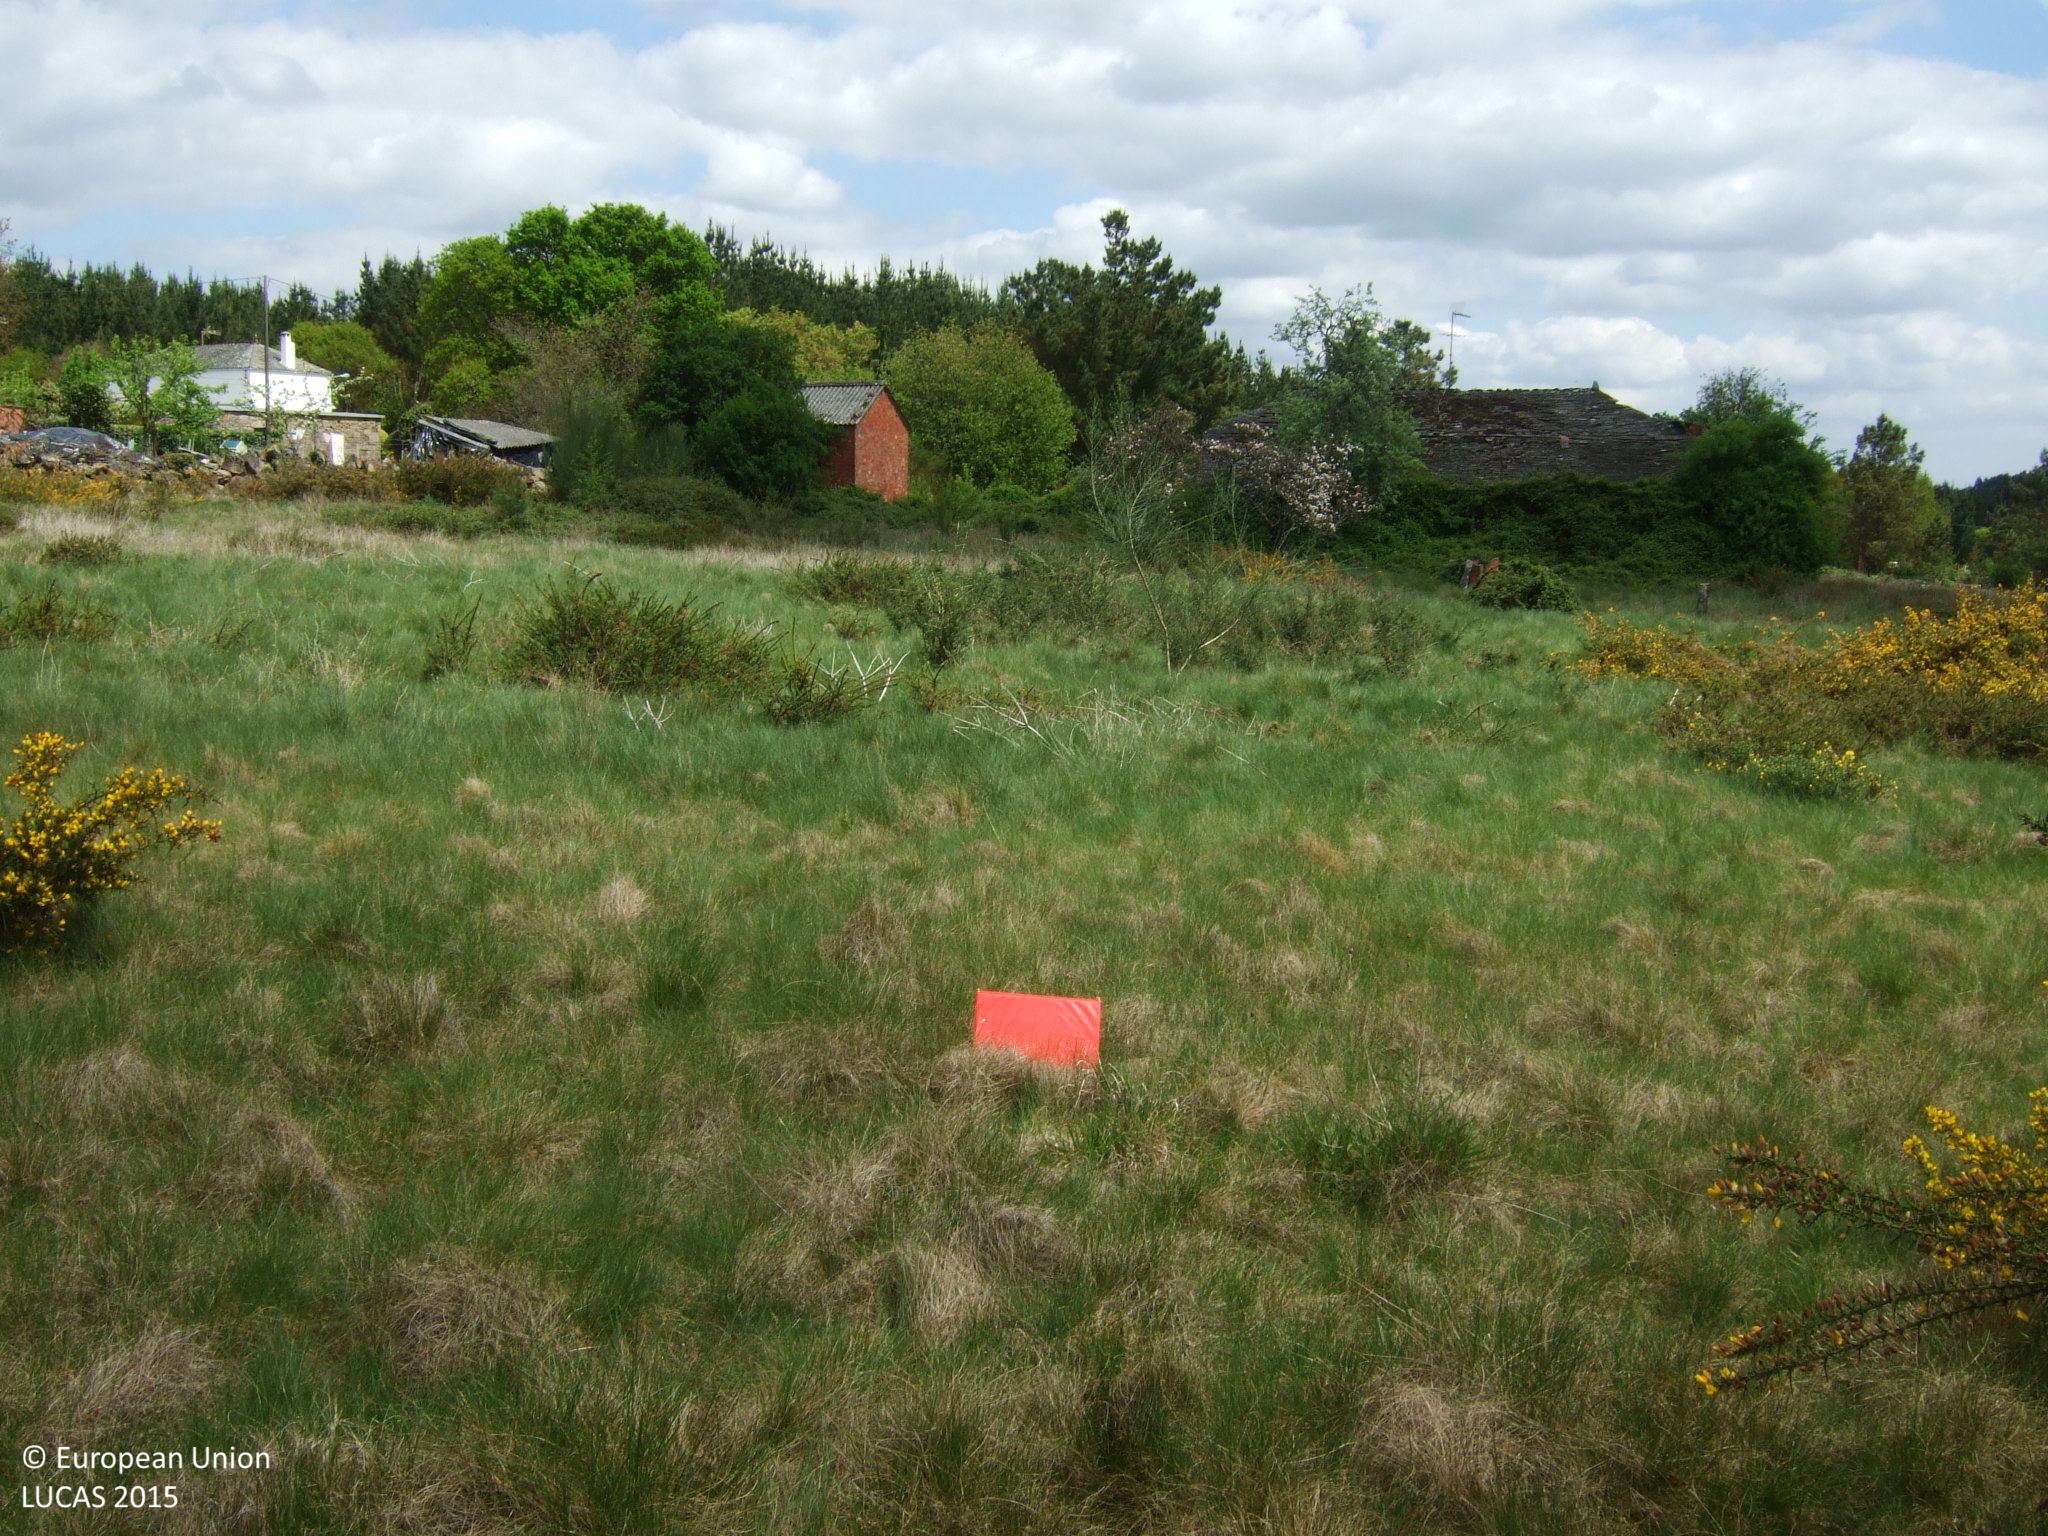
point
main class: Grassland
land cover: Grassland without tree/shrub cover
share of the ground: > 75 %
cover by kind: herbaceous plants 95 %, shrubs 5 %
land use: Semi-natural and natural areas not in use
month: April
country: ES
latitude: 43.1279
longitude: -7.6974
